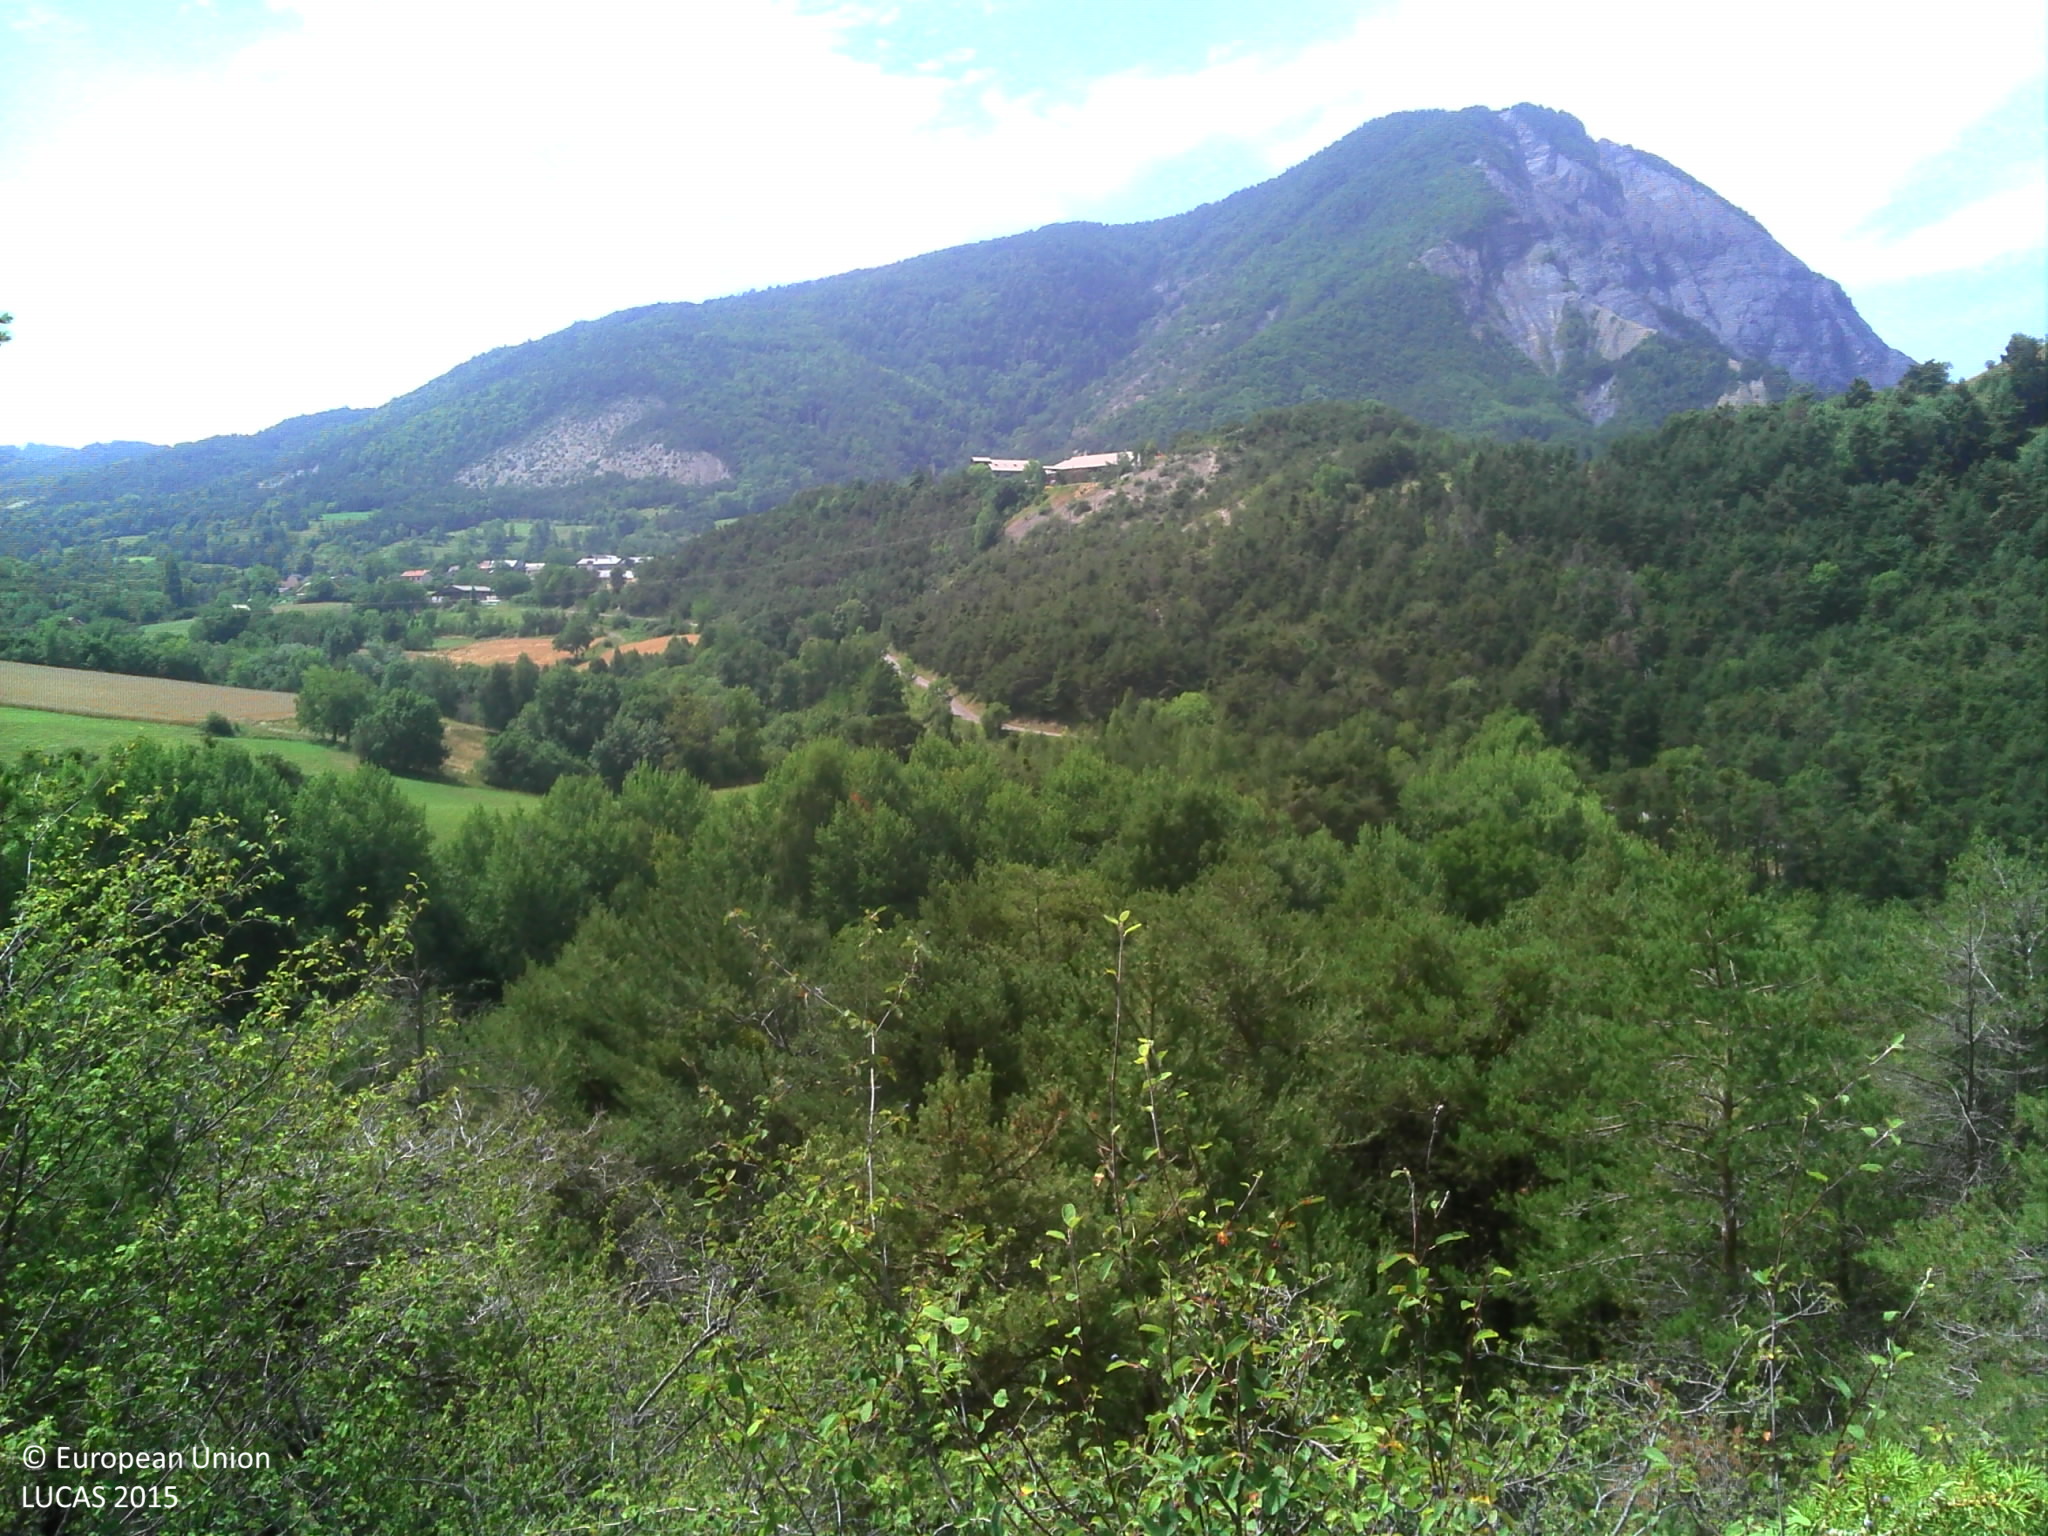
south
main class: Shrubland
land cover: Shrubland with sparse tree cover
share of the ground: 50 - 75 %
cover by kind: shrubs 50 %, unconsolidated bare surface 25 %, herbaceous plants 20 %, coniferous forest trees 5 %
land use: Semi-natural and natural areas not in use
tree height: < 5 m
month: July
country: FR
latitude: 44.4651
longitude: 6.2987
